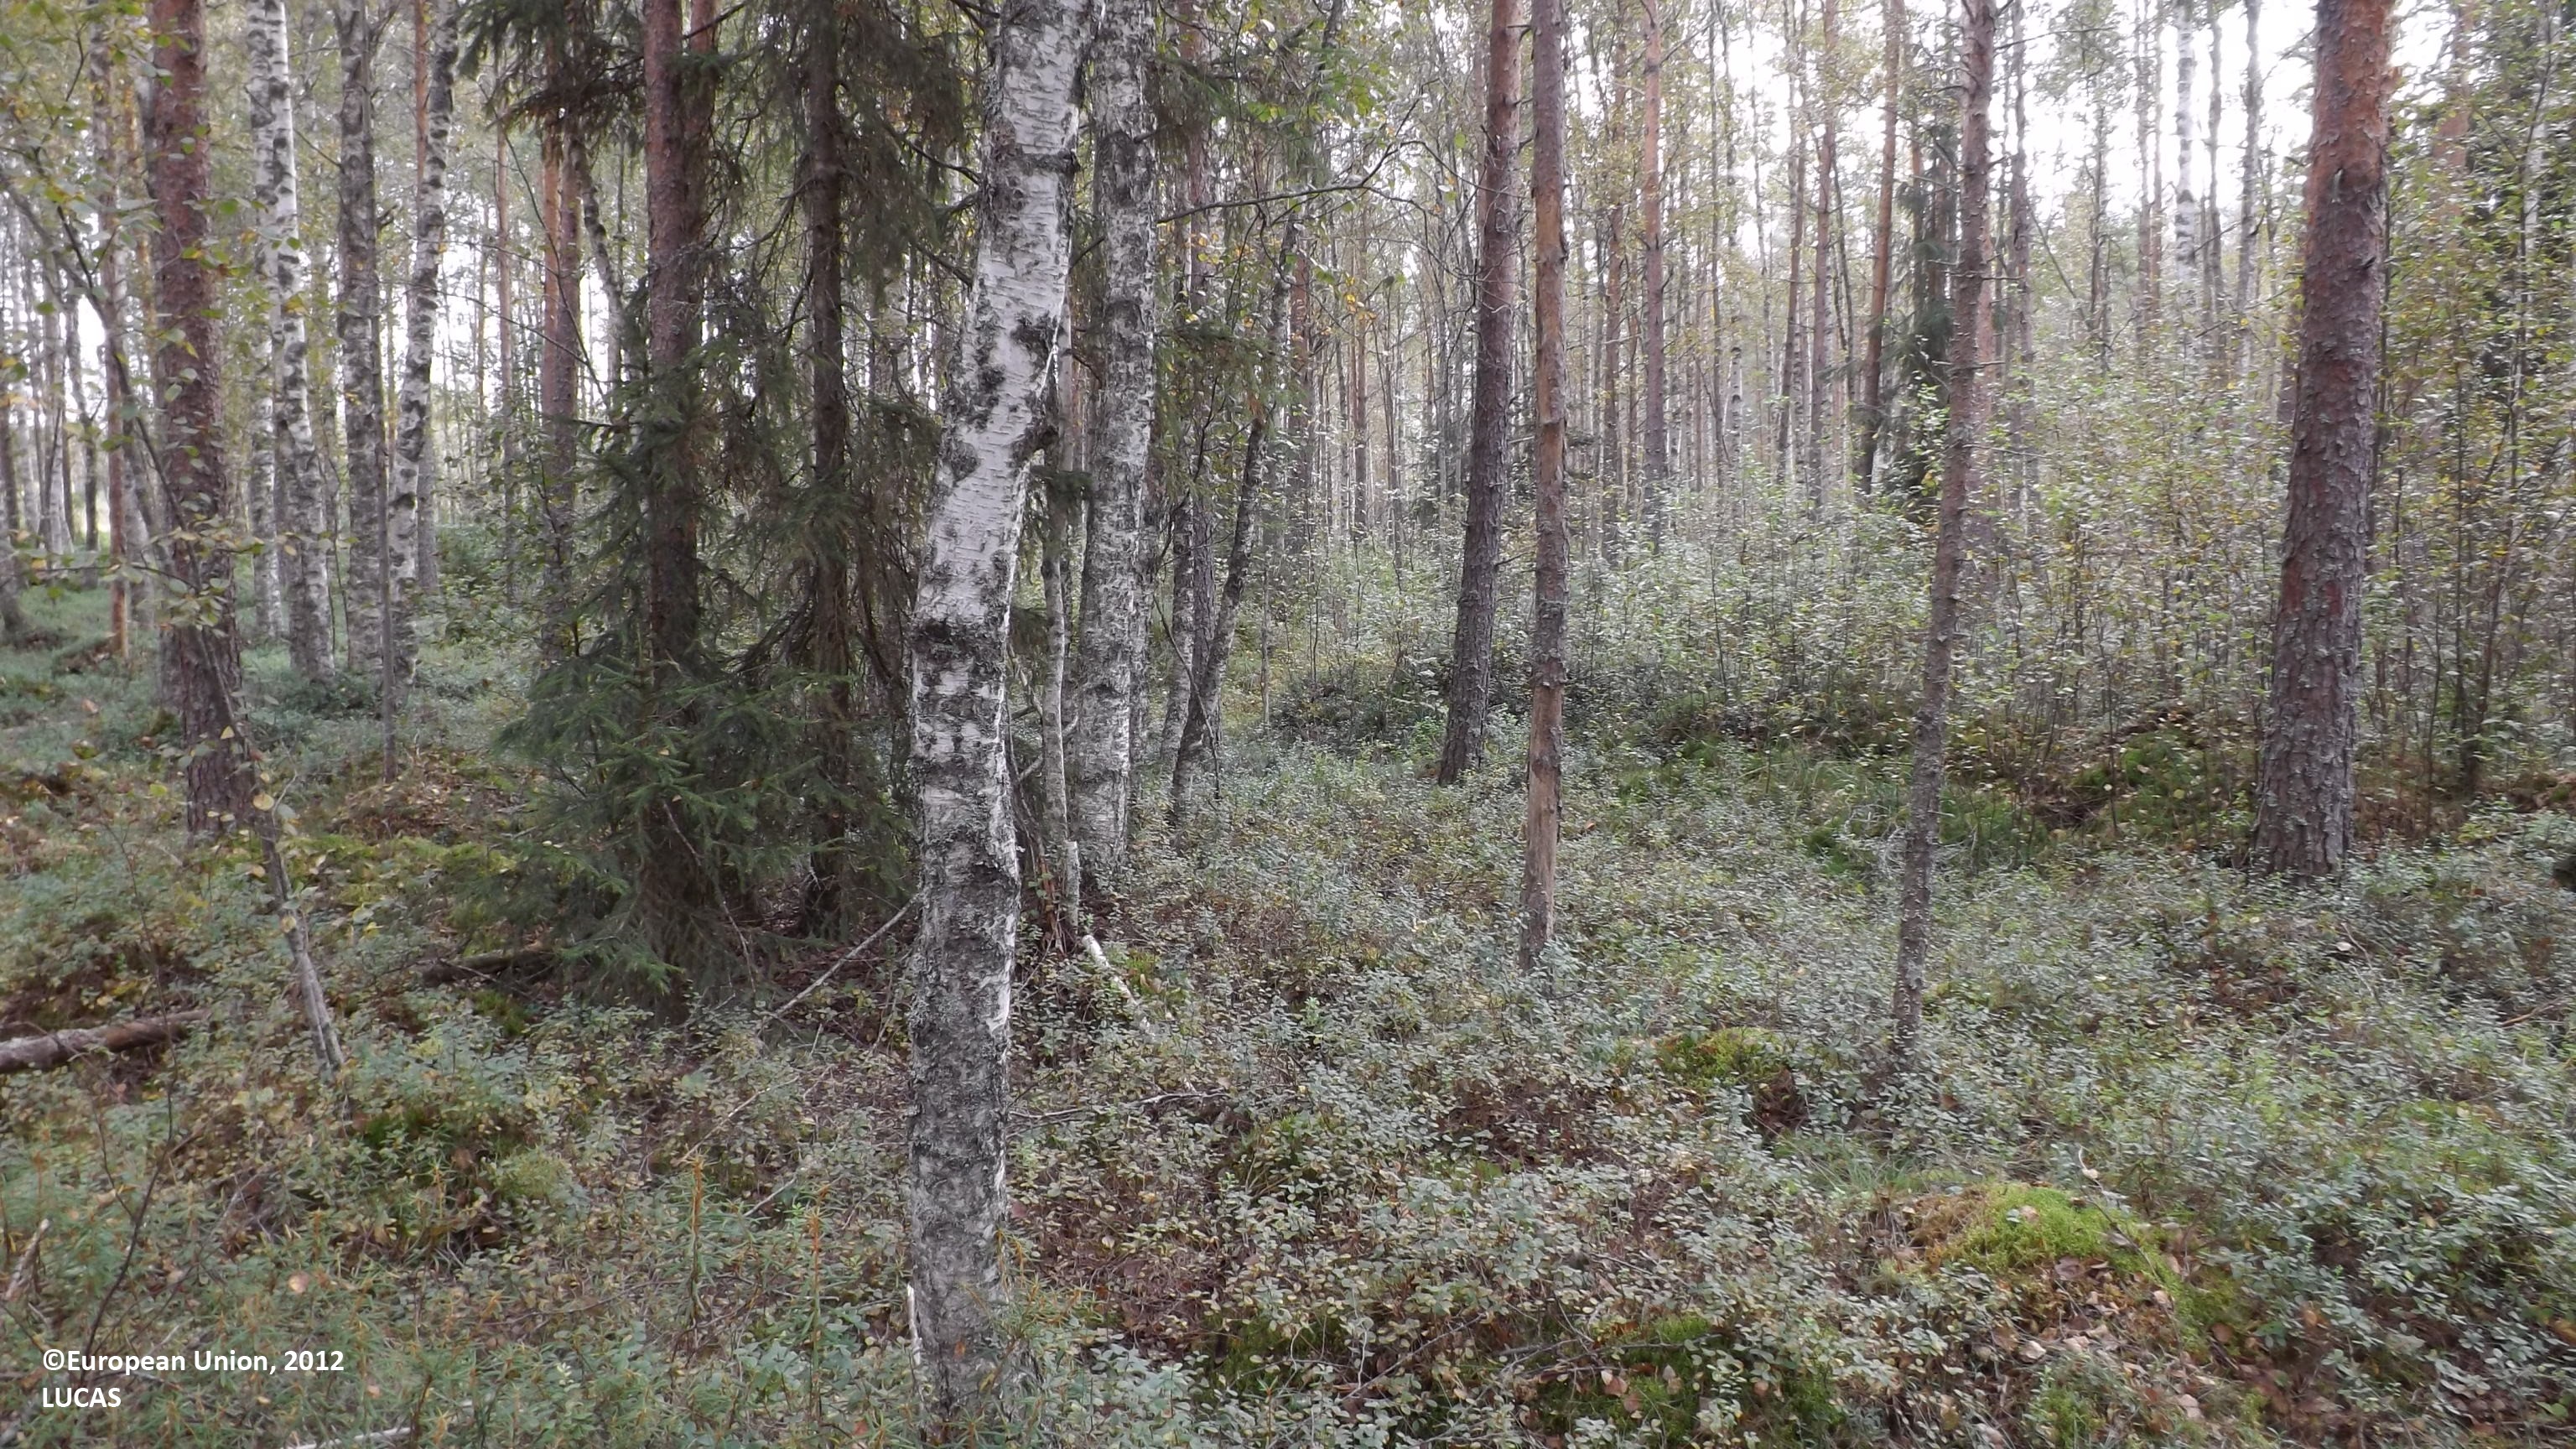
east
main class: Woodland
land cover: Pine dominated mixed woodland
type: boreal forest
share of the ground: 50 - 75 %
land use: Forestry
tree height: > 5 m
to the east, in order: Pine dominated mixed woodland; Ditches and canals; Pine dominated mixed woodland; Ditches and canals; Broadleaved woodland; Pine dominated mixed woodland; Ditches and canals; Grassland with sparse tree/shrub cover; Ditches and canals; Grassland with sparse tree/shrub cover; Ditches and canals; Shrubland with sparse tree cover; Ditches and canals; Shrubland with sparse tree cover
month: August
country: FI
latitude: 63.7419
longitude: 23.7385
